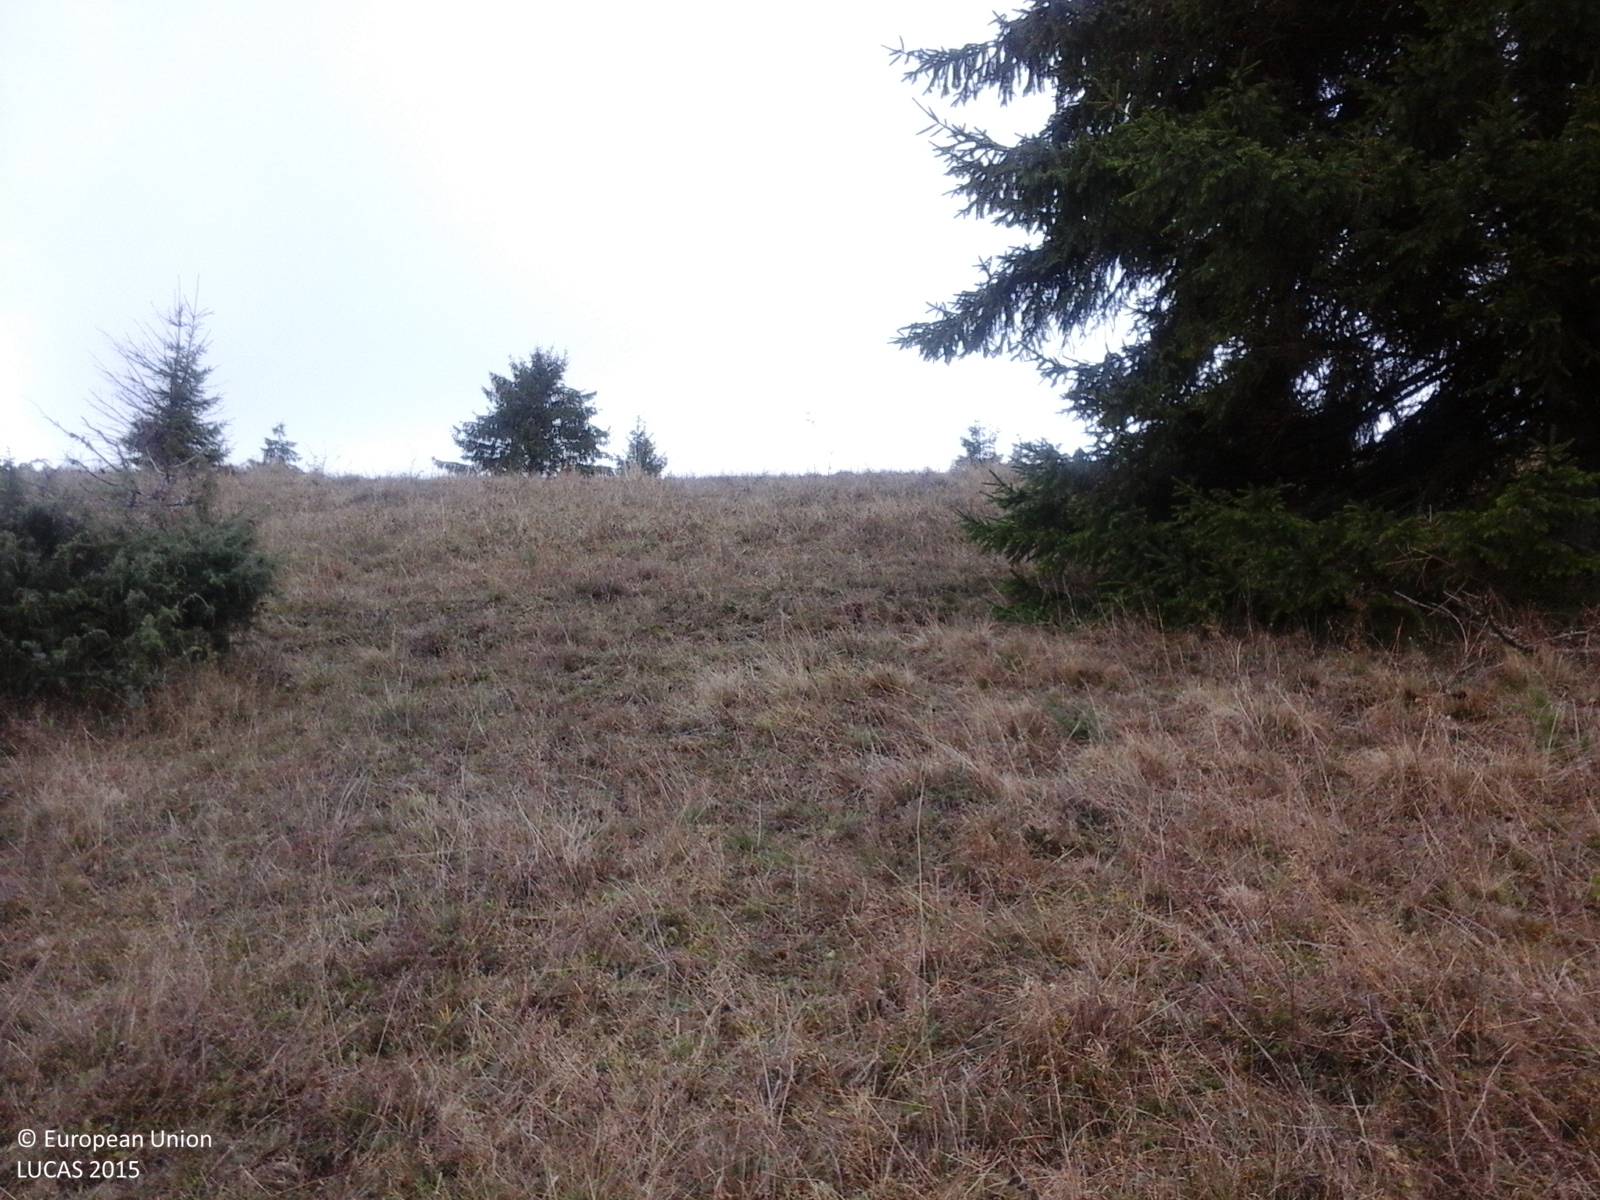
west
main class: Grassland
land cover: Grassland with sparse tree/shrub cover
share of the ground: > 75 %
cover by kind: herbaceous plants 95 %, coniferous forest trees 5 %
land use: Agriculture (excluding fallow land and kitchen gardens)
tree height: > 5 m
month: October
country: RO
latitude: 46.8798
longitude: 25.5036
